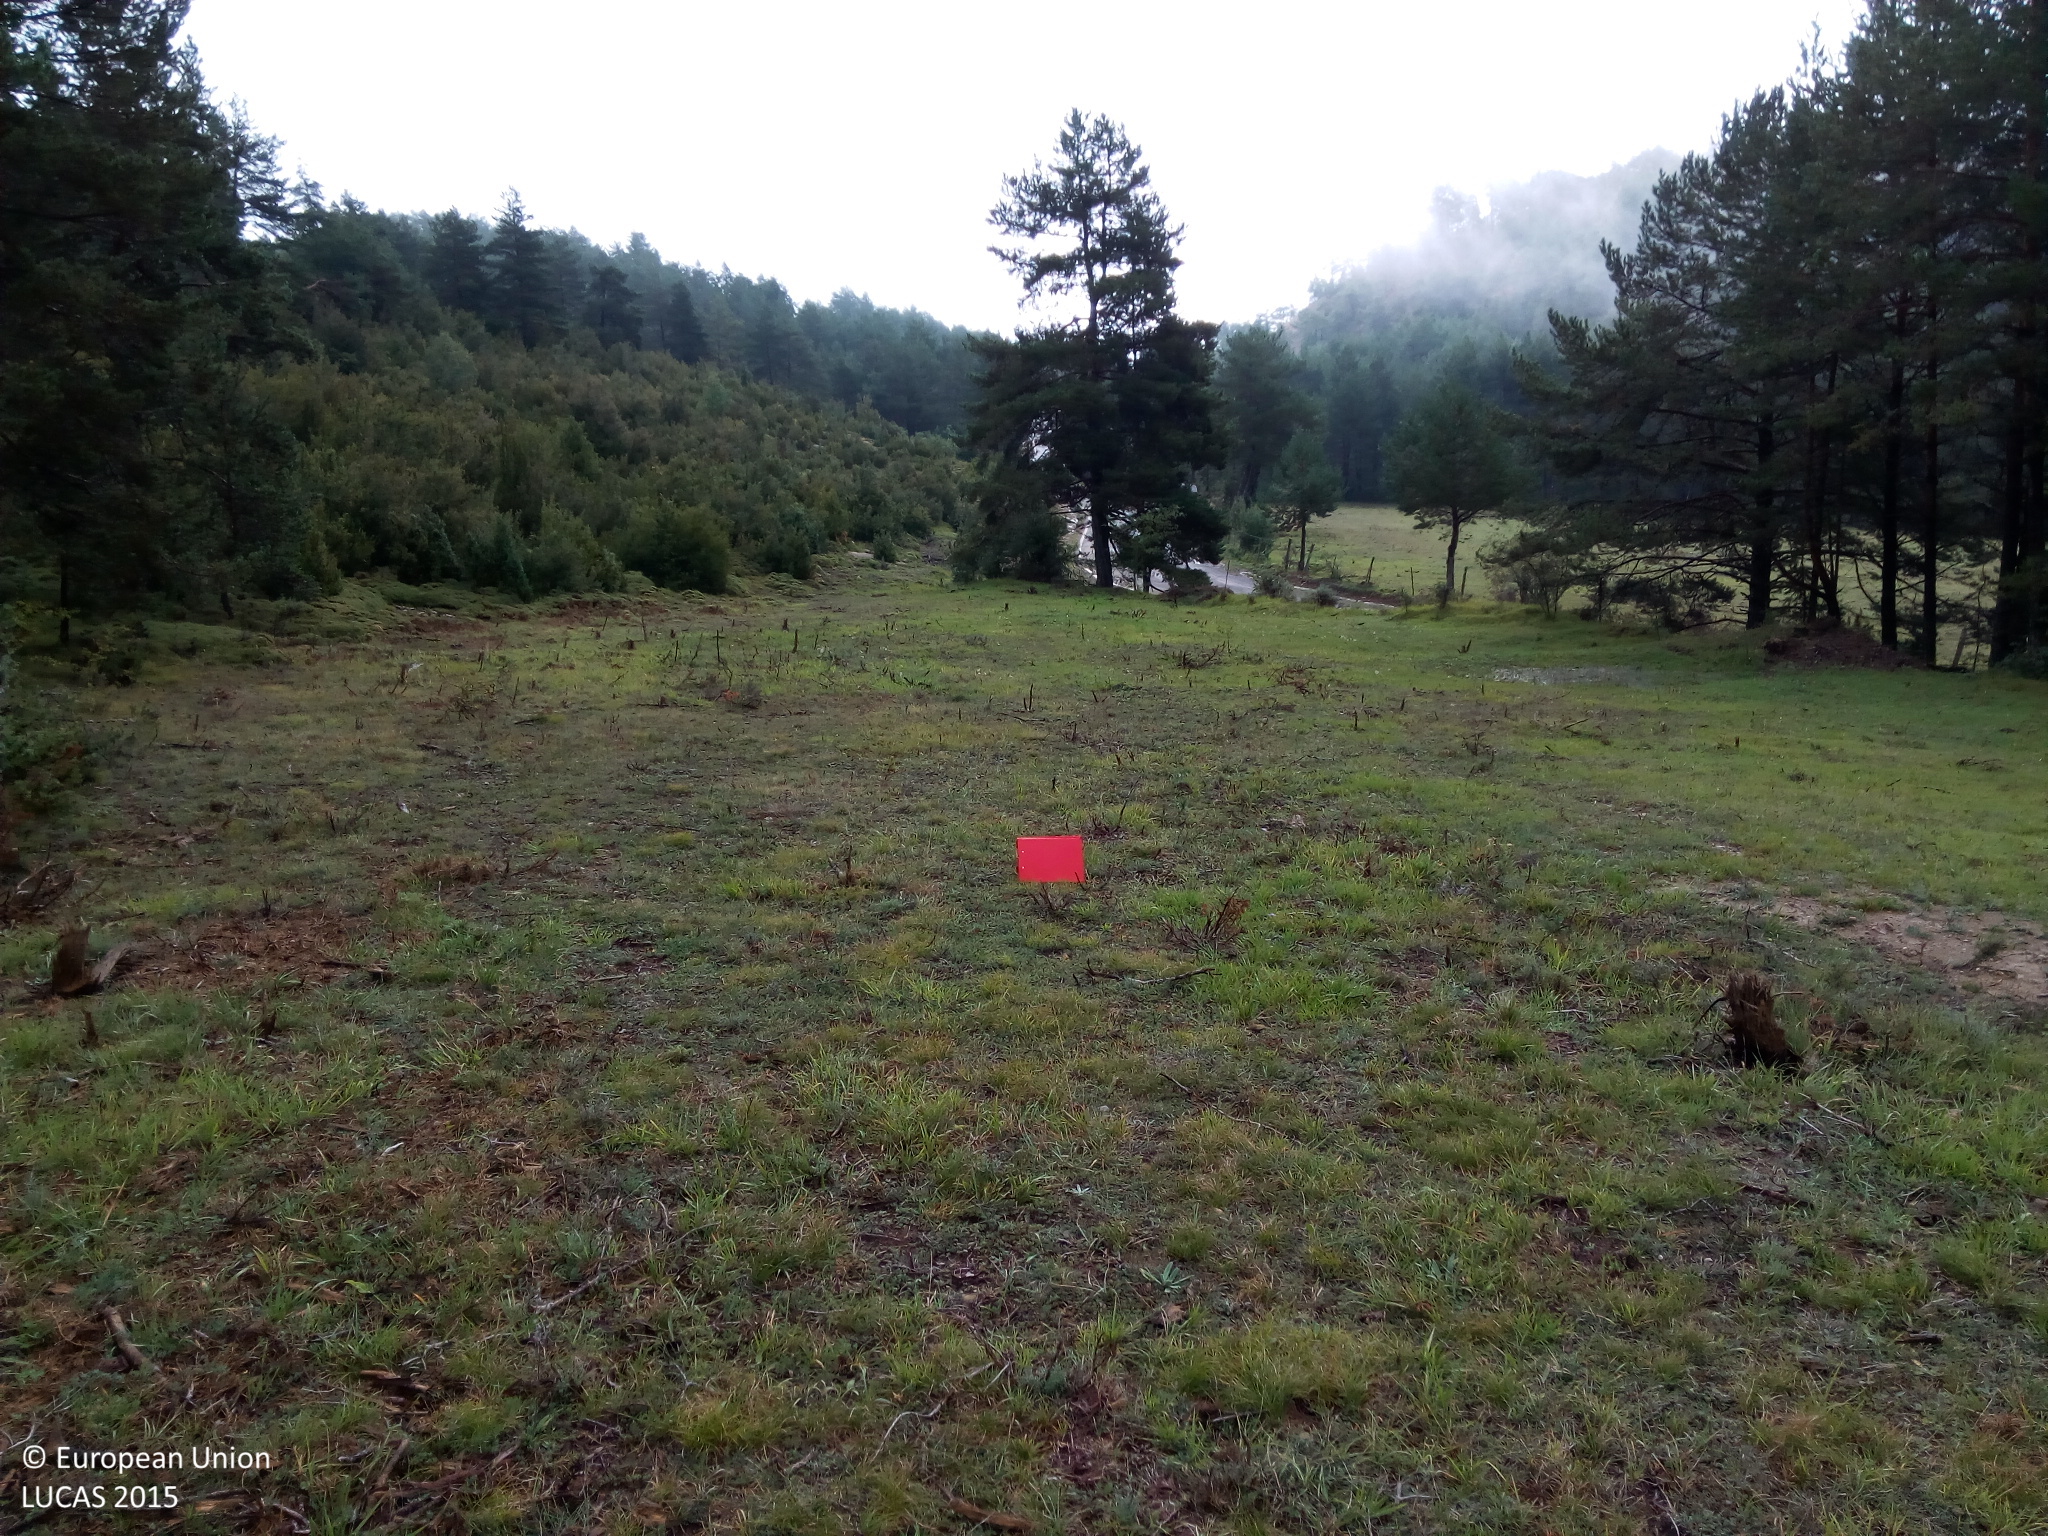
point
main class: Grassland
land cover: Grassland without tree/shrub cover
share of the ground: > 75 %
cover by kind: herbaceous plants 100 %
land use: Forestry
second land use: Agriculture (excluding fallow land and kitchen gardens)
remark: Clear cut
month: September
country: ES
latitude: 42.4055
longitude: -0.0707
